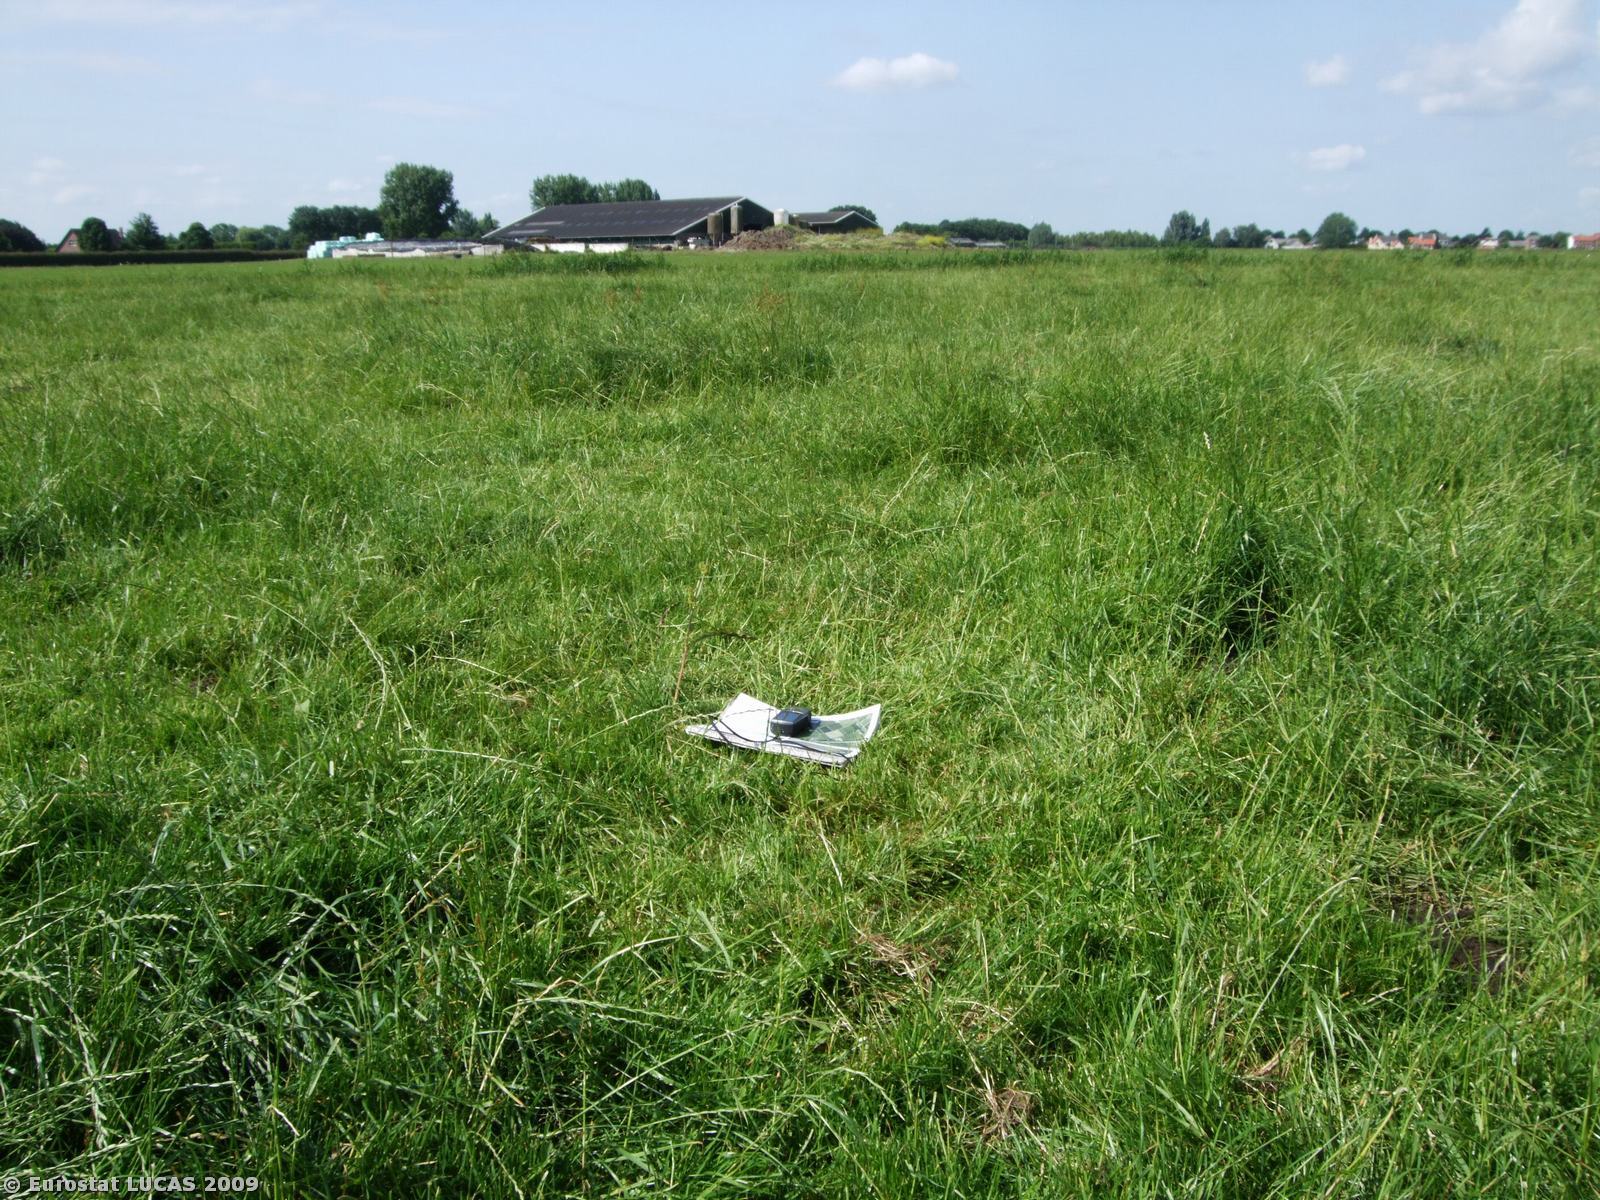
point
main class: Grassland
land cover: Grassland without tree/shrub cover
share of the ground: > 75 %
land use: Agriculture (excluding fallow land and kitchen gardens)
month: July
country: NL
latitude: 51.9435
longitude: 5.3282
